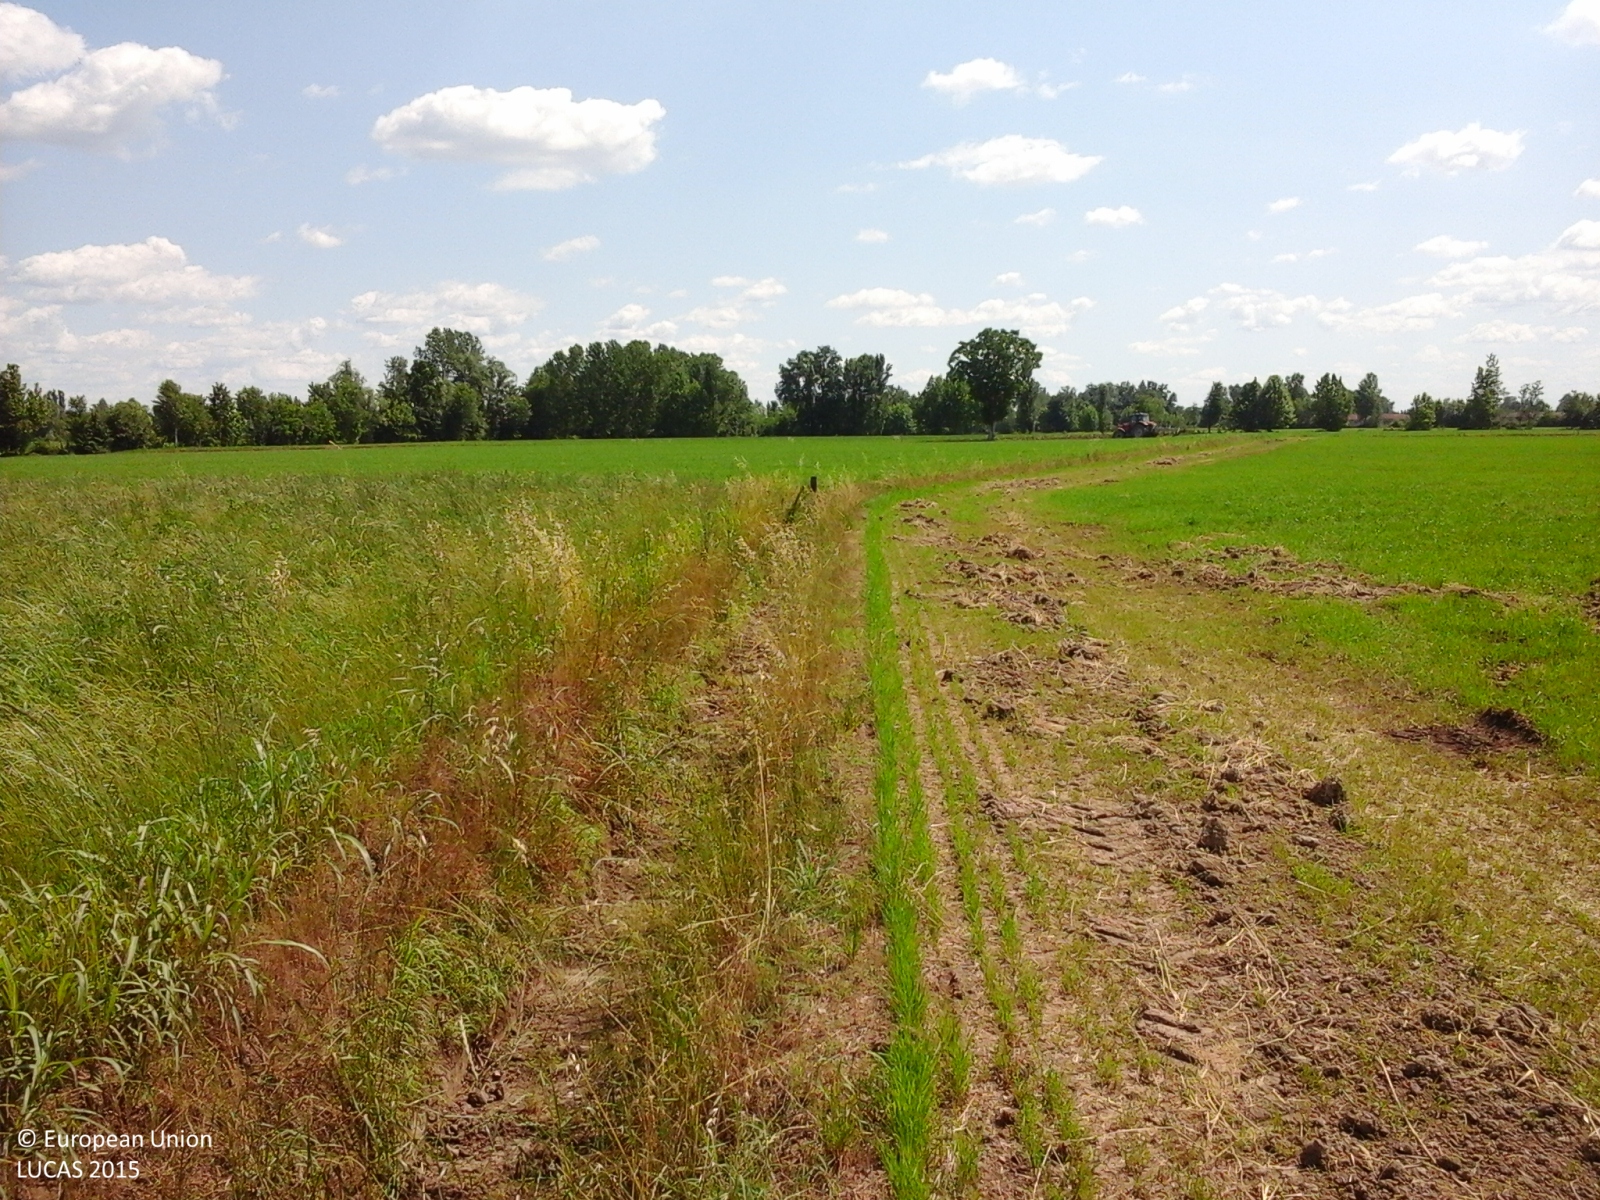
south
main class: Grassland
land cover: Grassland without tree/shrub cover
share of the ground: > 75 %
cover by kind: herbaceous plants 100 %
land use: Agriculture (excluding fallow land and kitchen gardens)
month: May
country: IT
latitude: 45.3419
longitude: 10.2675
